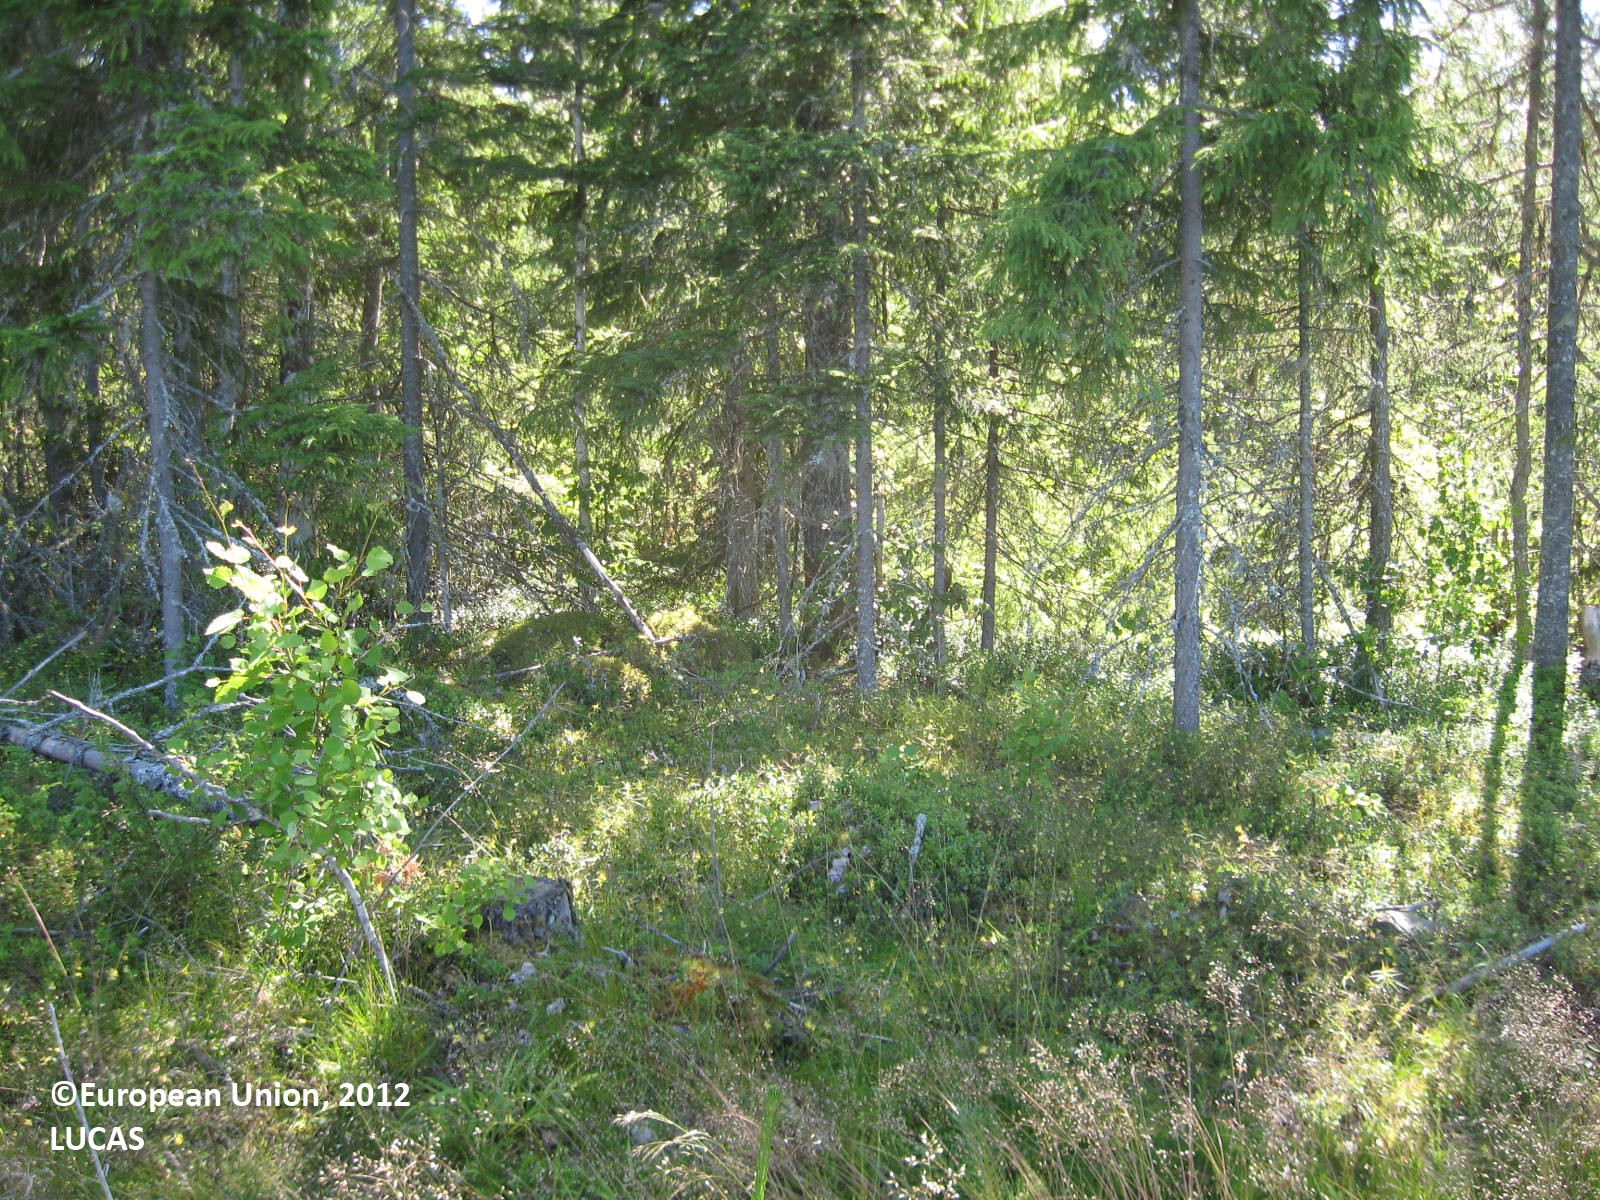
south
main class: Woodland
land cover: Other mixed woodland
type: boreal forest
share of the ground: 10 - 25 %
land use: Forestry
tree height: < 5 m
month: July
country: FI
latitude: 62.0987
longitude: 21.4821
